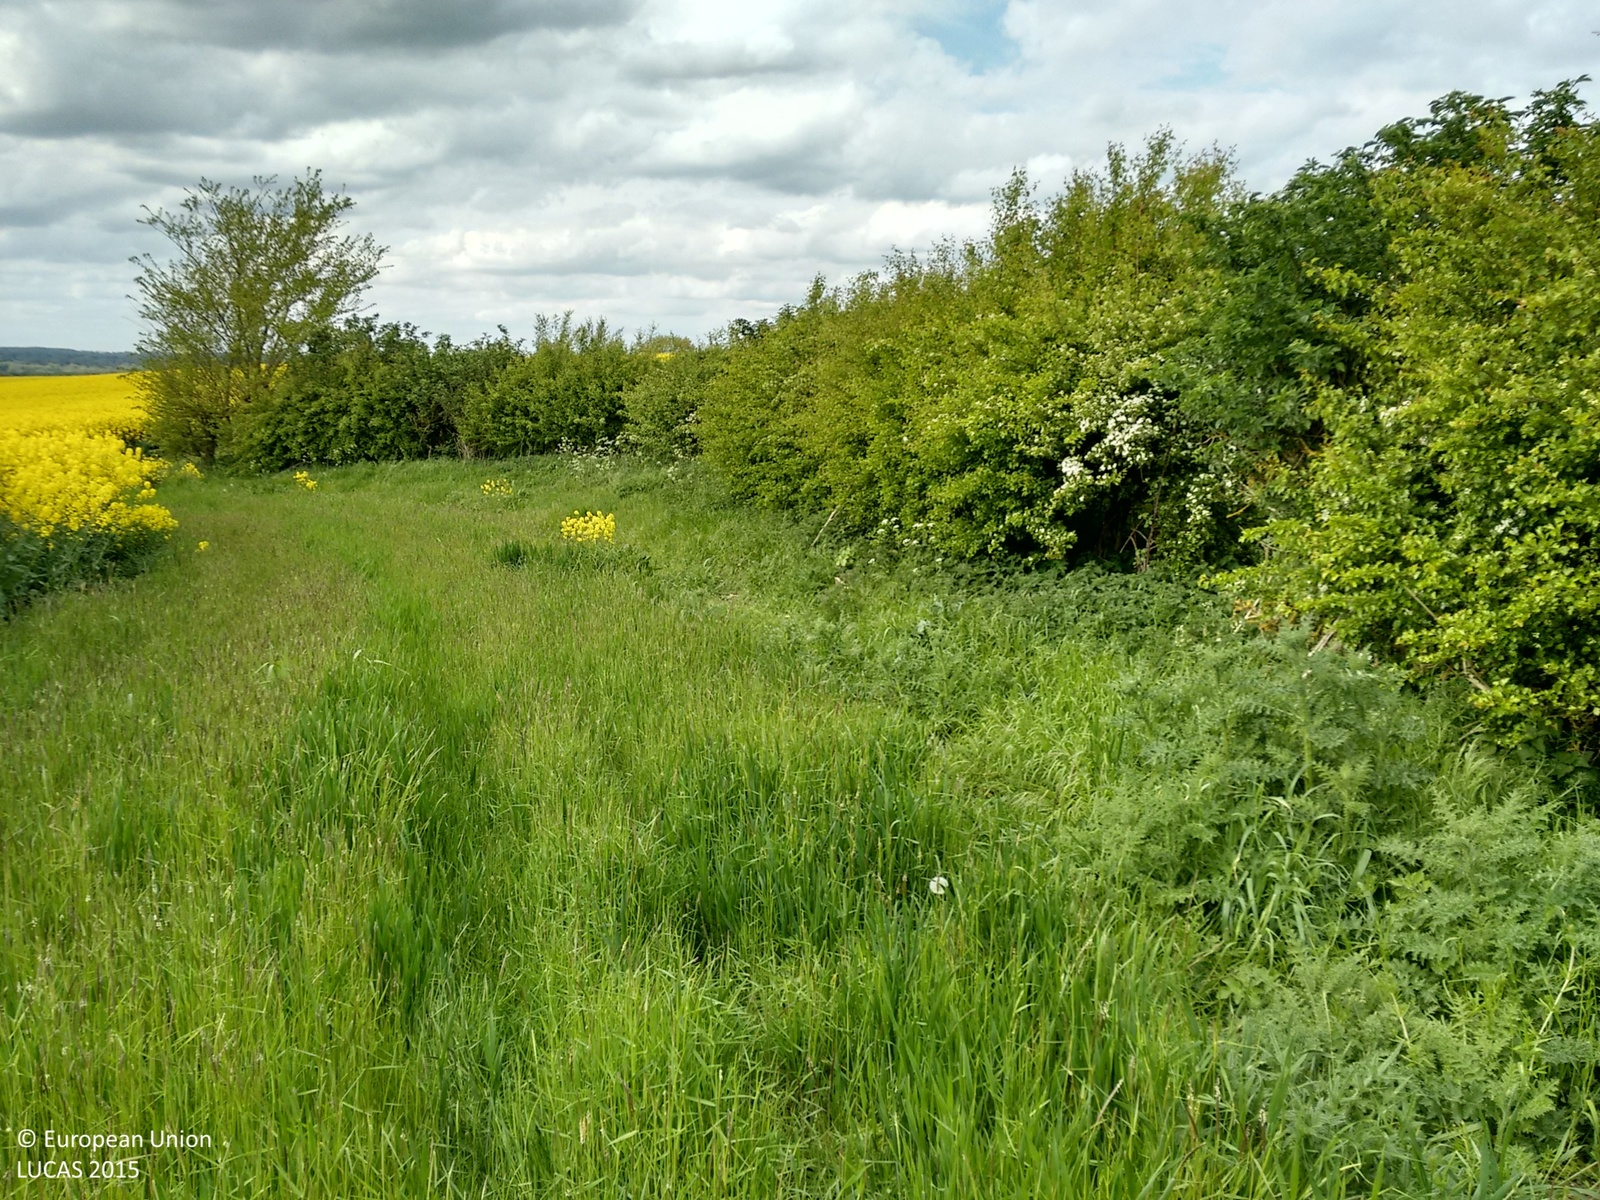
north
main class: Grassland
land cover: Grassland without tree/shrub cover
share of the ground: > 75 %
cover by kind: herbaceous plants 100 %
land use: Agriculture (excluding fallow land and kitchen gardens)
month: May
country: GB
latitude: 52.2007
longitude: -0.4997
